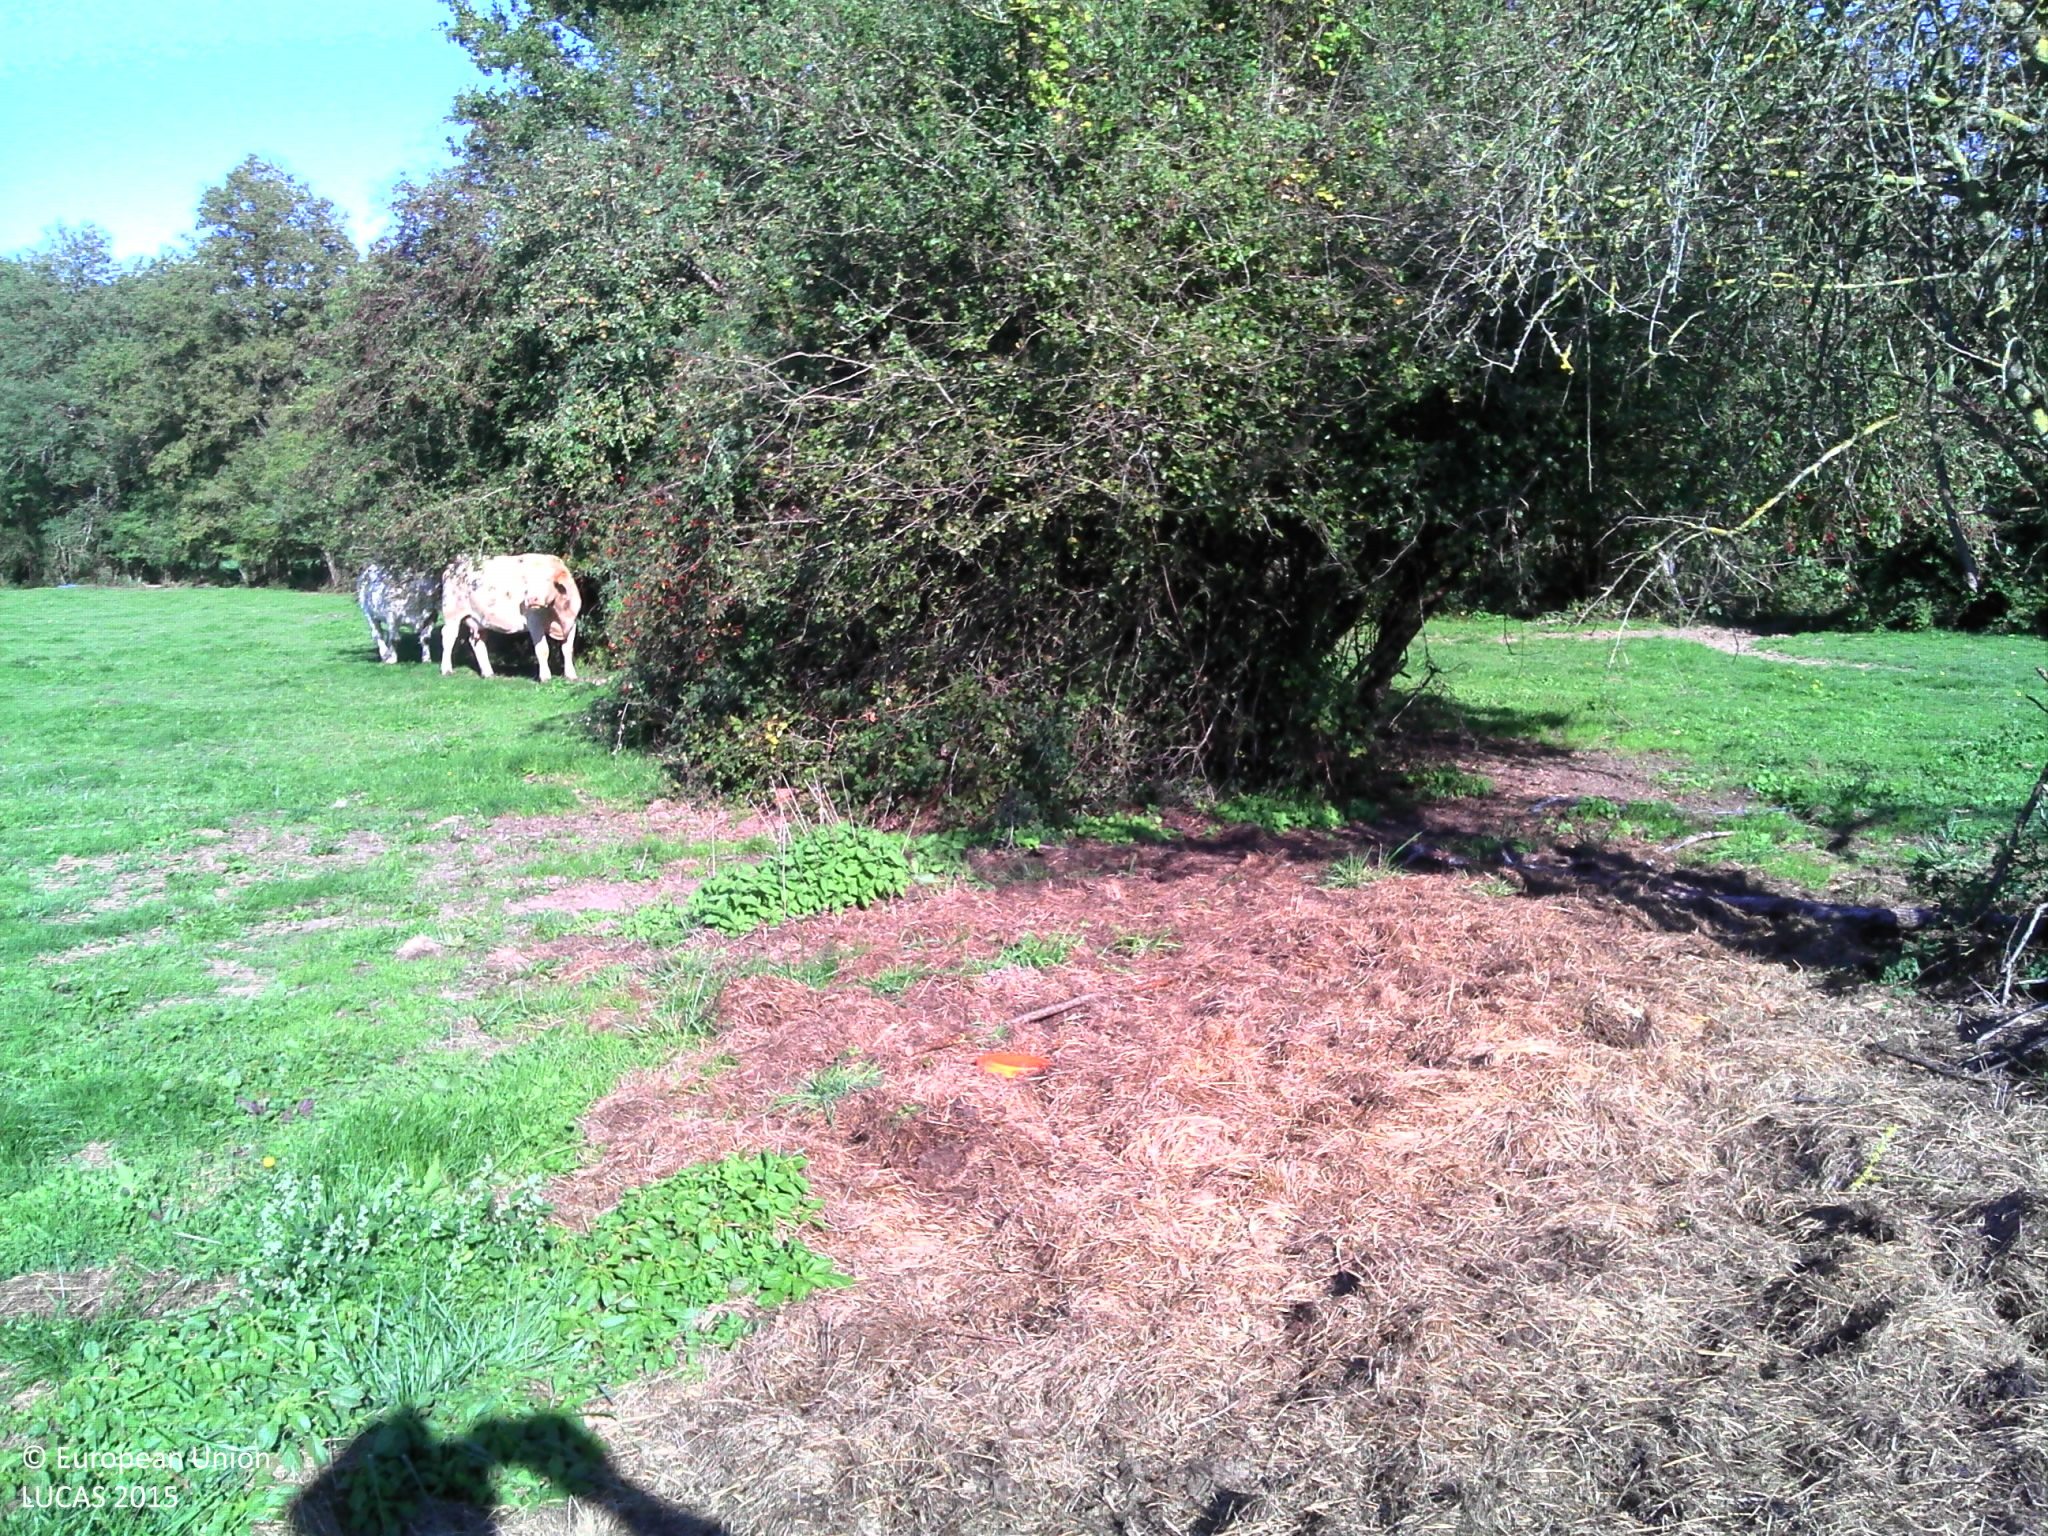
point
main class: Grassland
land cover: Grassland with sparse tree/shrub cover
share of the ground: > 75 %
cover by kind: herbaceous plants 95 %, broadleaved forest trees 5 %
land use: Agriculture (excluding fallow land and kitchen gardens)
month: September
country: FR
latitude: 48.0721
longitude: 3.8895
